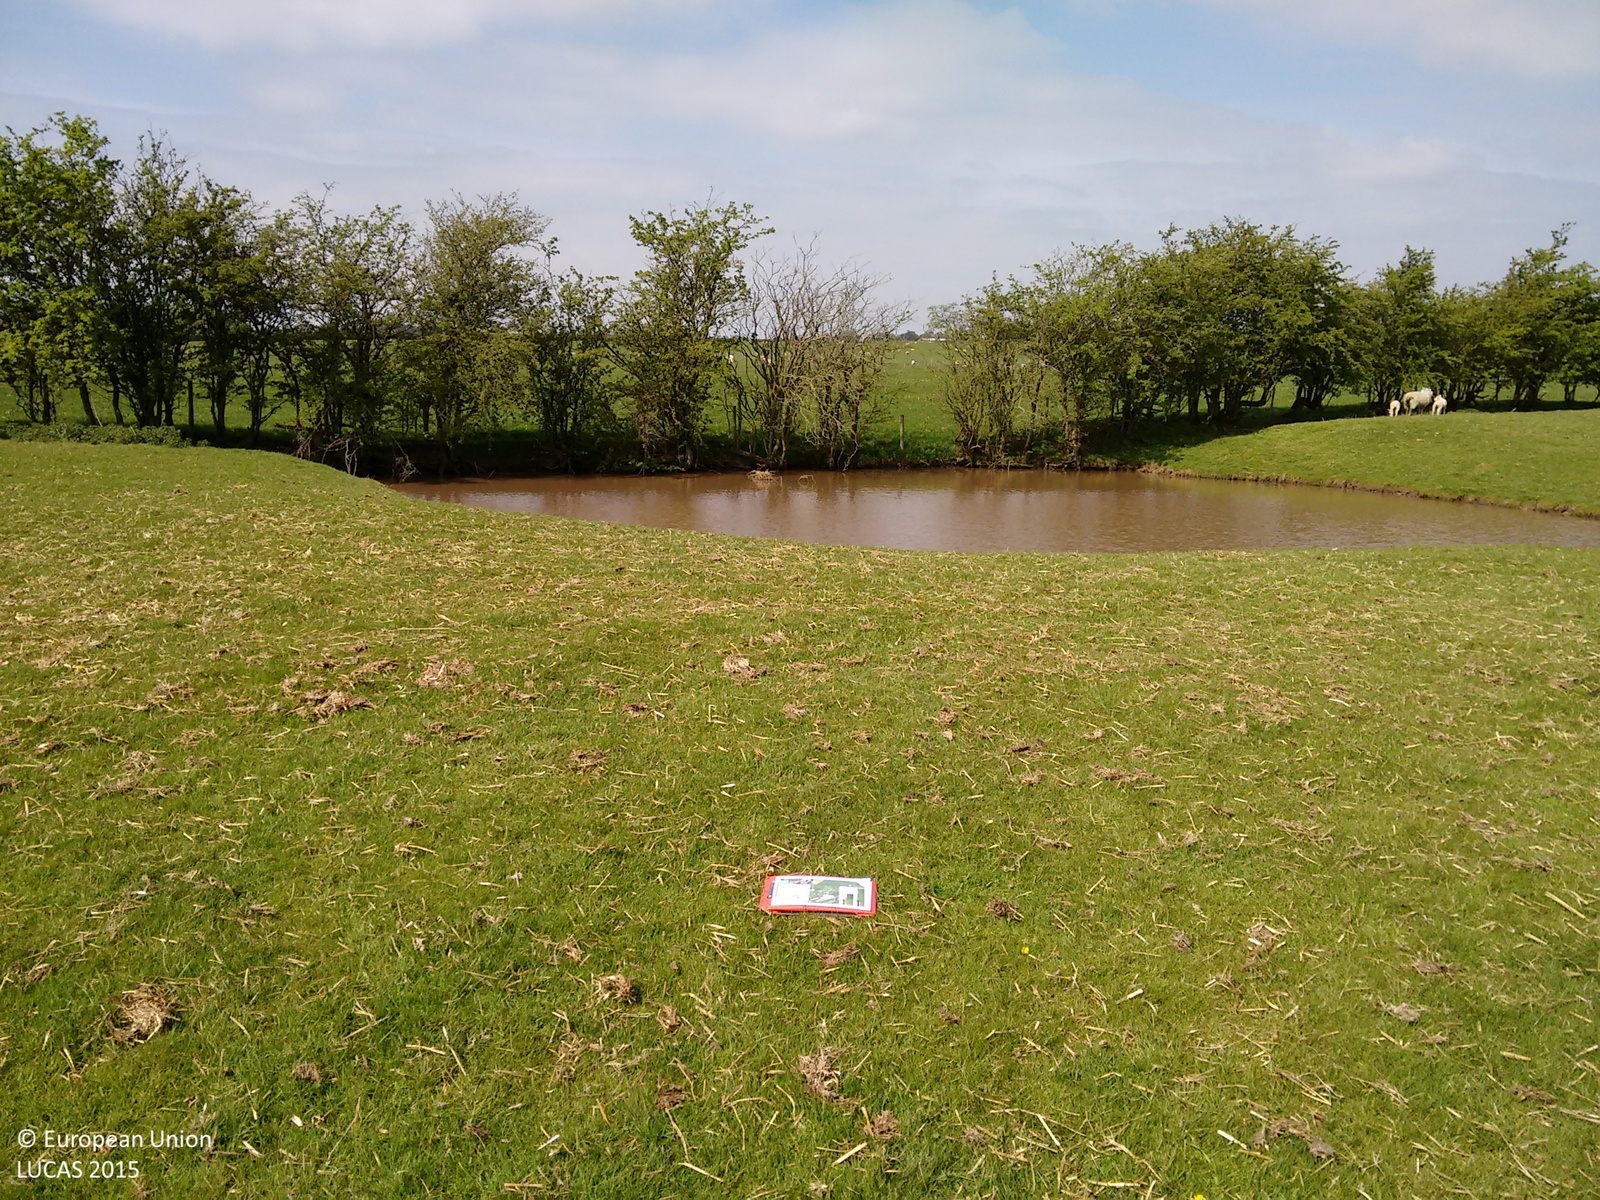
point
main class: Grassland
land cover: Grassland without tree/shrub cover
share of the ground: > 75 %
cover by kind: herbaceous plants 100 %
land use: Agriculture (excluding fallow land and kitchen gardens)
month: May
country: GB
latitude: 53.8712
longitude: -2.5831
